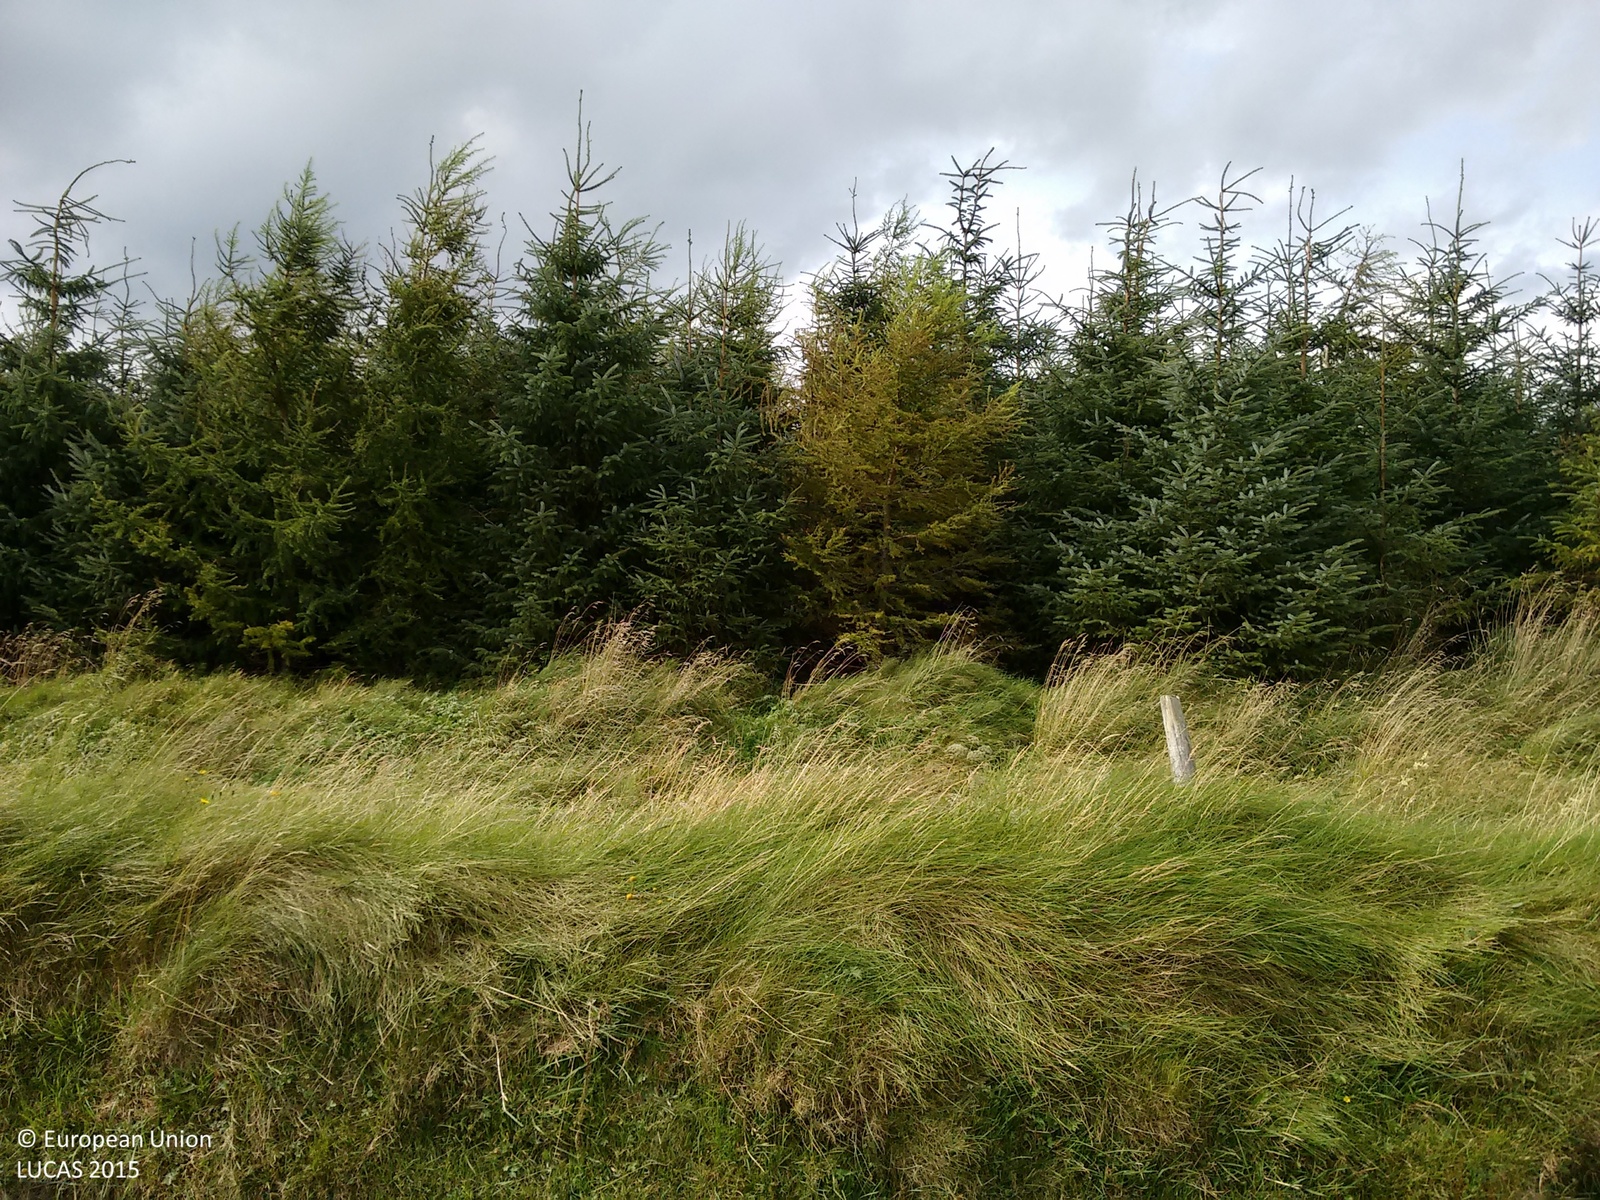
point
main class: Woodland
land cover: Spruce dominated coniferous woodland
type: exotic forest
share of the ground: > 75 %
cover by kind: coniferous forest trees 100 %
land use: Forestry
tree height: > 5 m
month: September
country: IE
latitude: 54.1365
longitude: -9.3419
